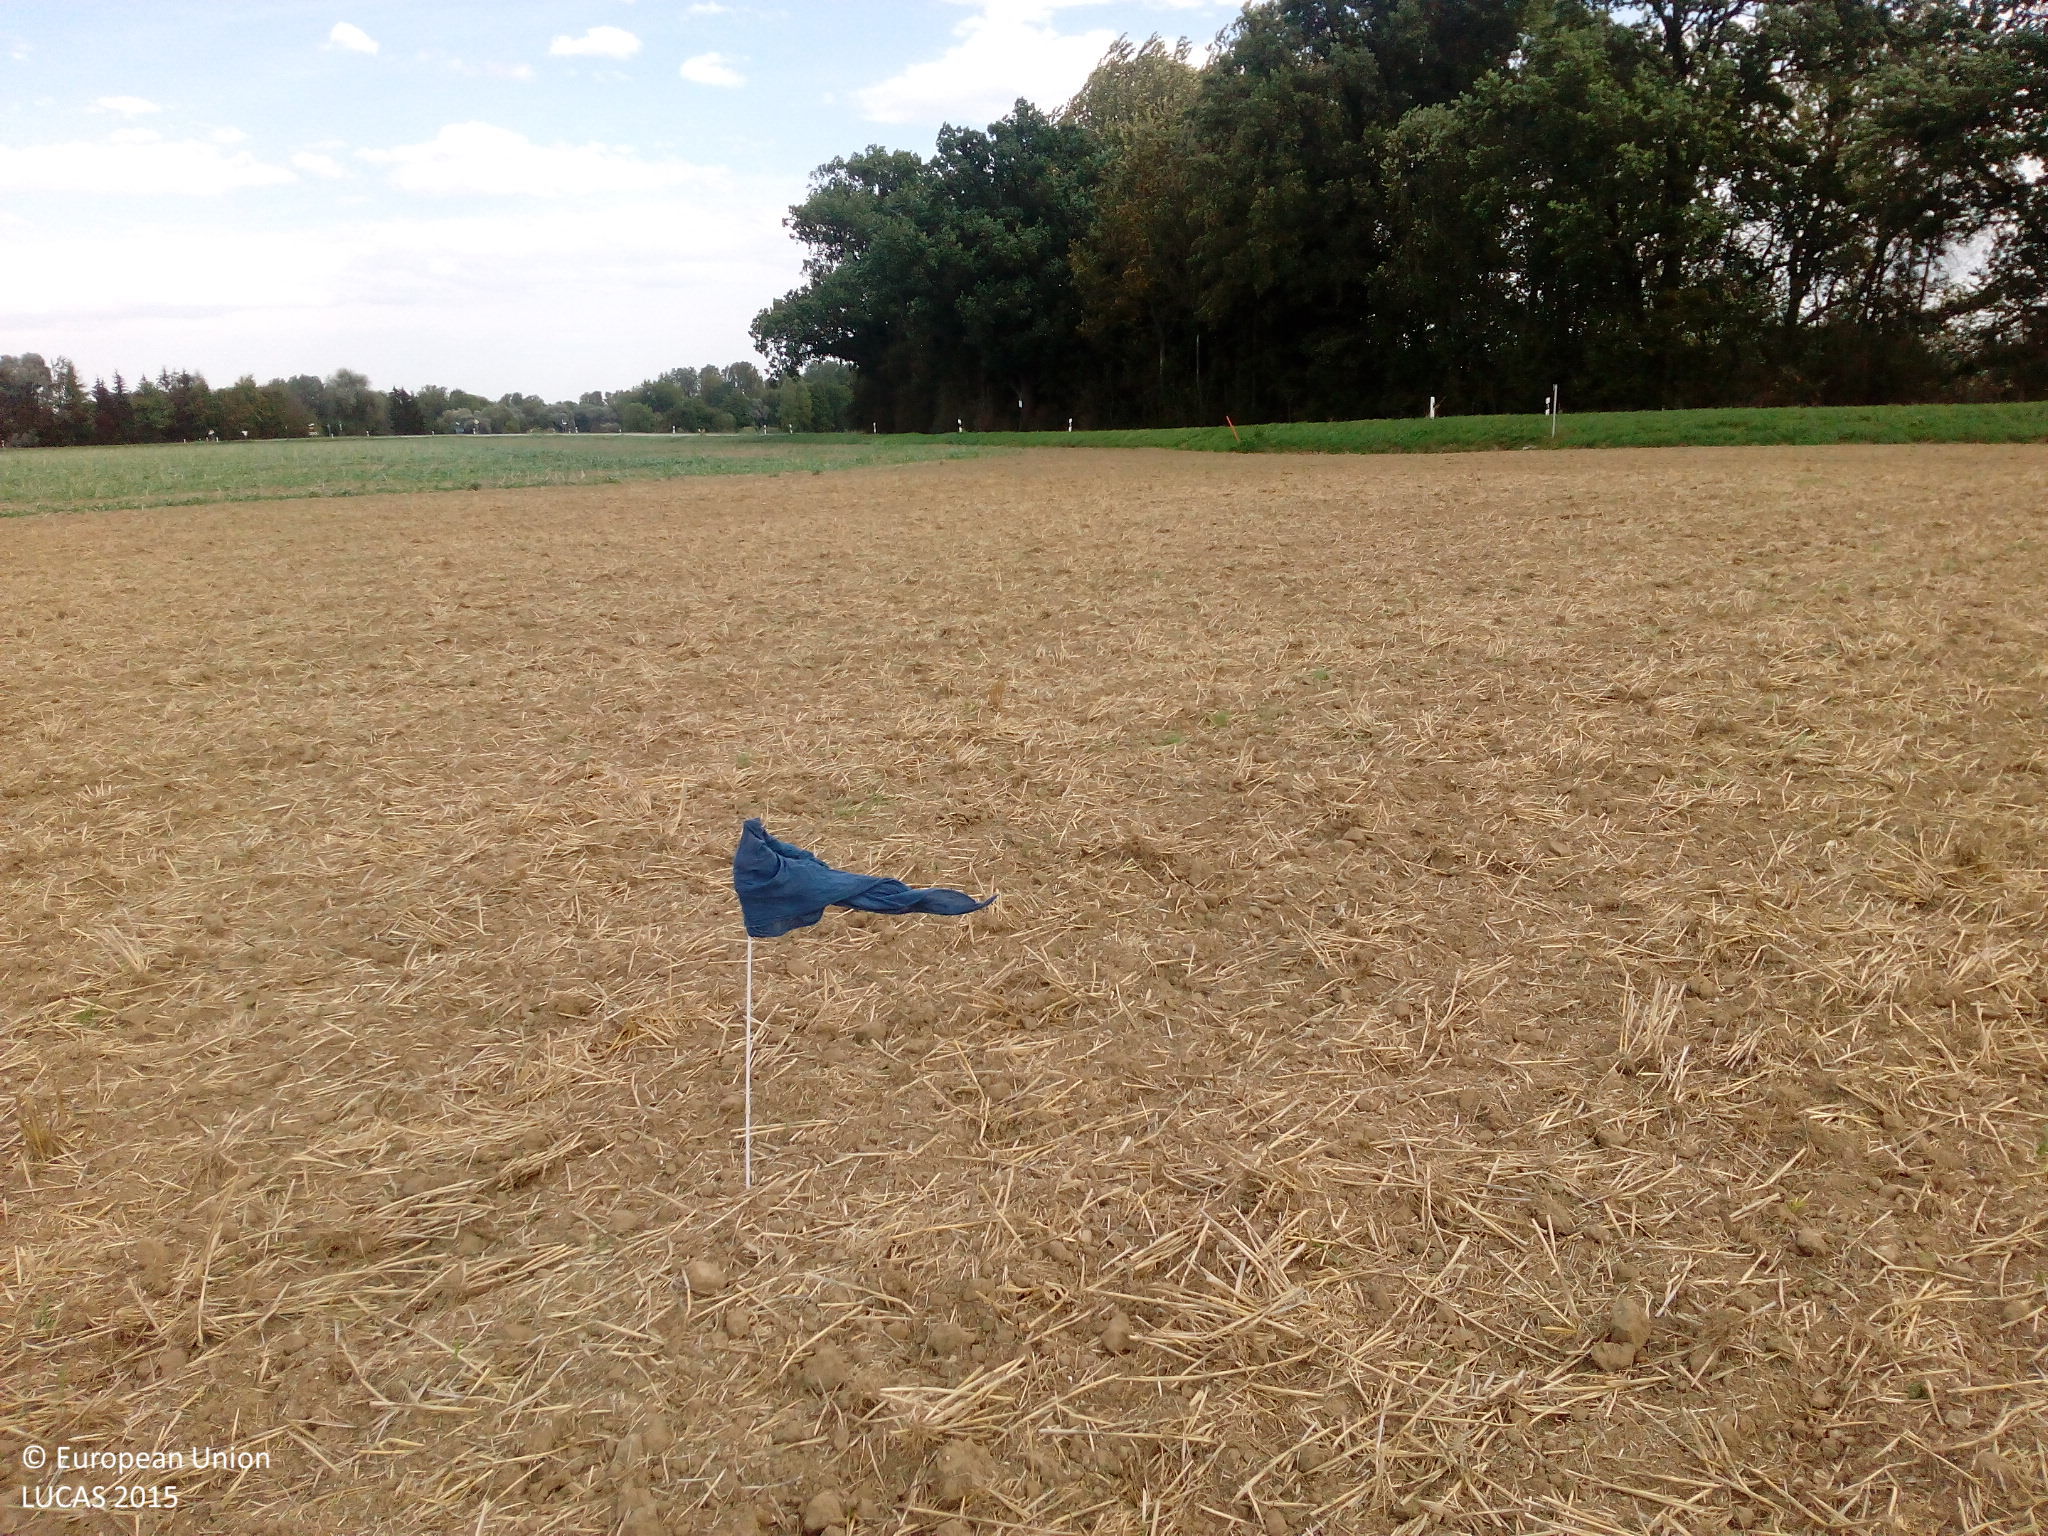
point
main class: Cropland
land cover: Common wheat
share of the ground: 10 - 25 %
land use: Agriculture (excluding fallow land and kitchen gardens)
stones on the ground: < 10 %
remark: Harvested field
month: September
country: DE
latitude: 48.4770
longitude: 11.9066
